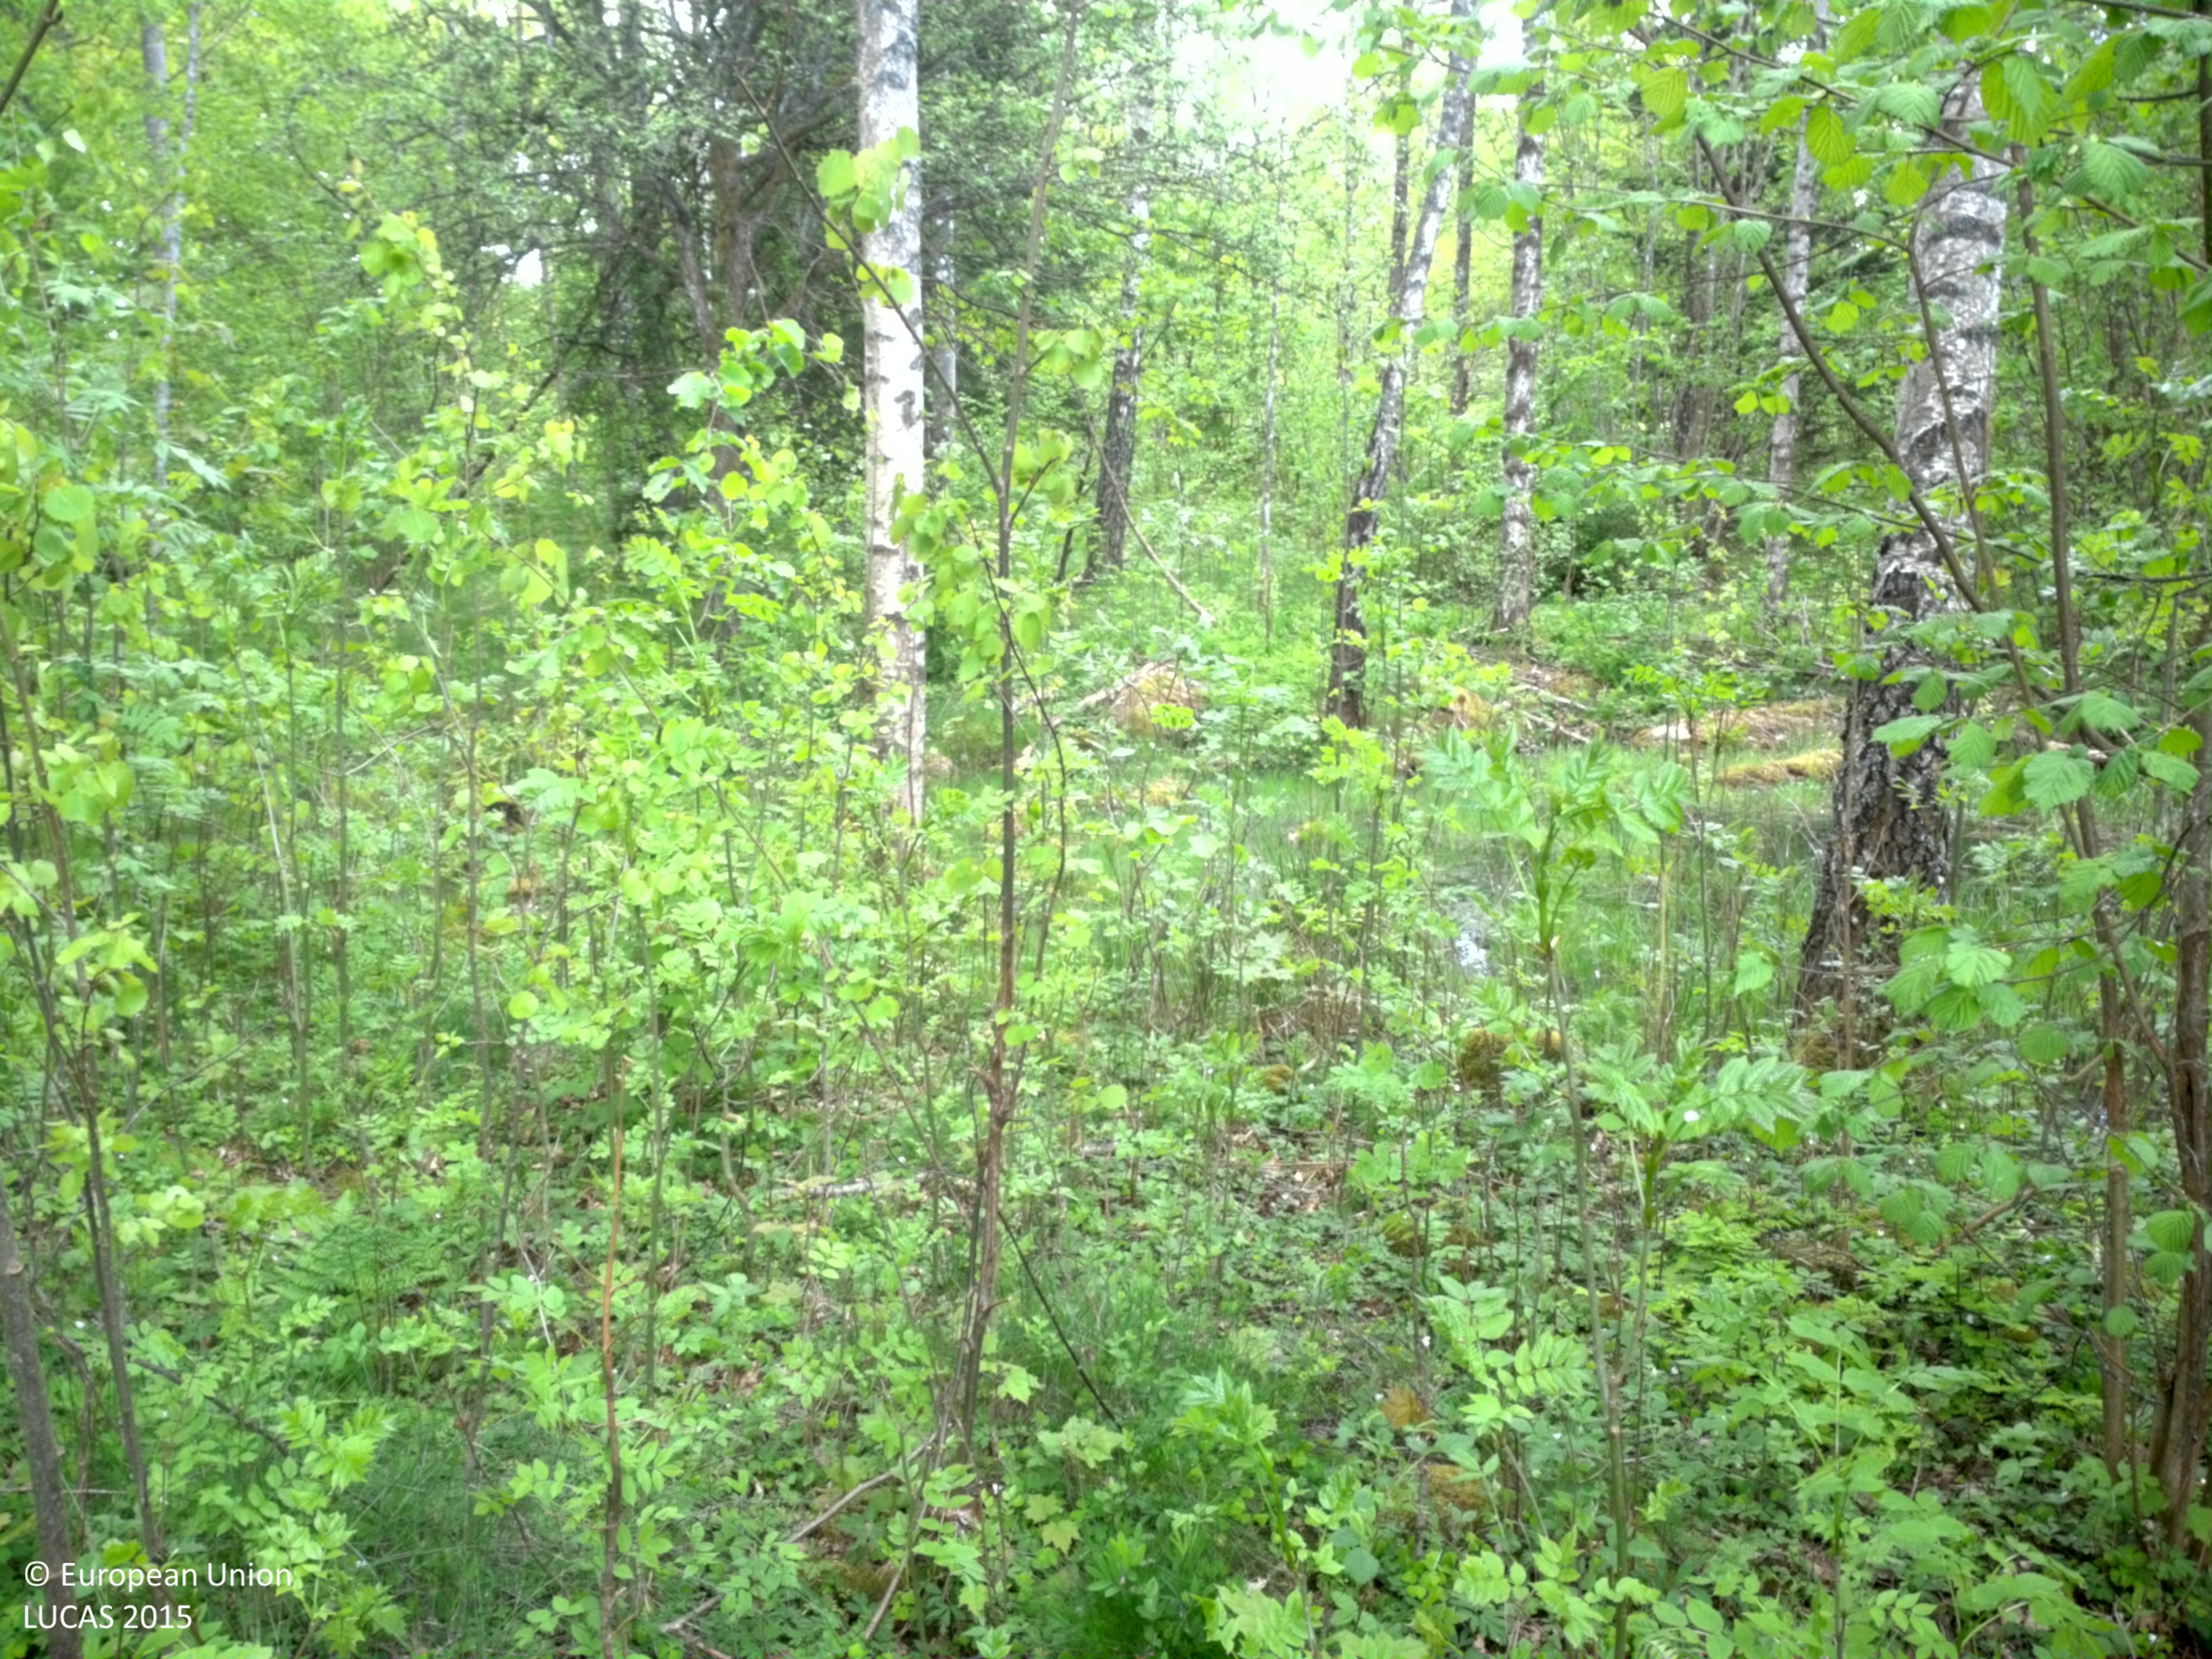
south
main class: Woodland
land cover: Broadleaved woodland
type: mesophytic deciduous forest
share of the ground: > 75 %
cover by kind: broadleaved forest trees 90 %, shrubs 5 %, herbaceous plants 5 %
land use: Forestry
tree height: > 5 m
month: May
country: SE
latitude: 56.5207
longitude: 15.0532
